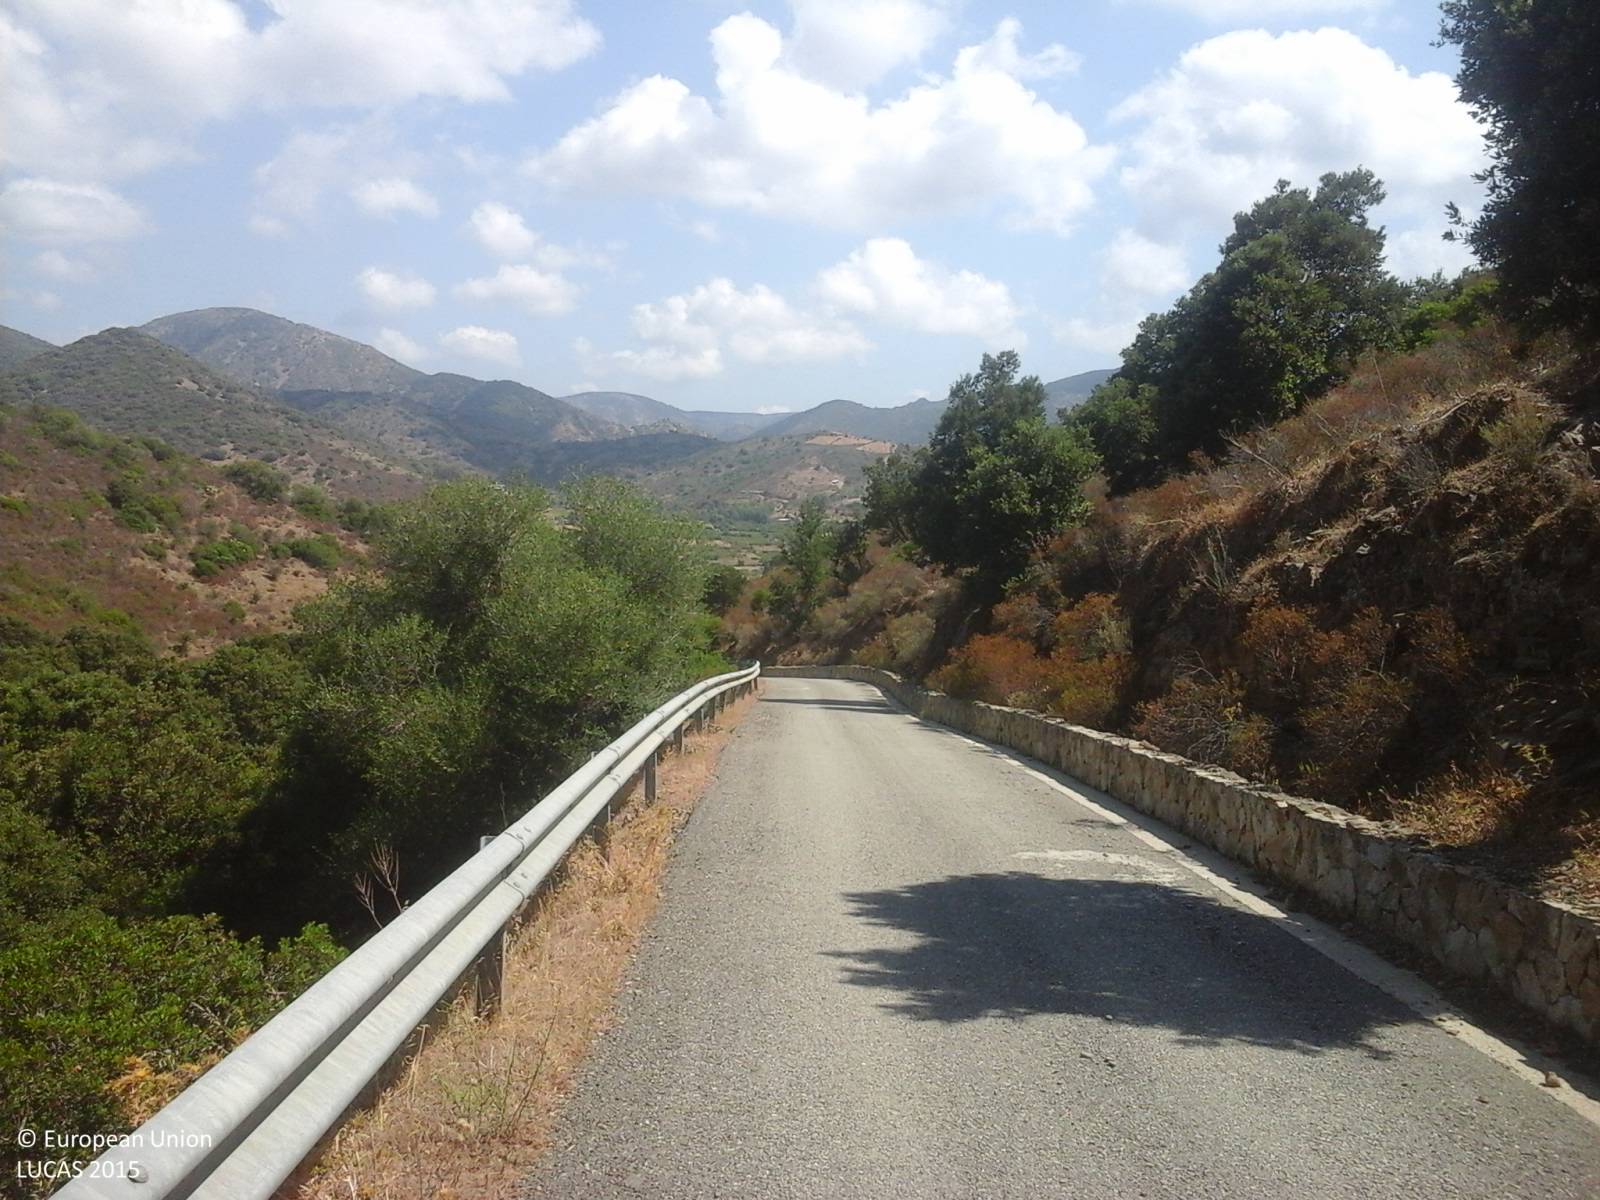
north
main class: Shrubland
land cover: Shrubland with sparse tree cover
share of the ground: > 75 %
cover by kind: shrubs 75 %, herbaceous plants 15 %, broadleaved forest trees 5 %, unconsolidated bare surface 5 %
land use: Agriculture (excluding fallow land and kitchen gardens)
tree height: < 5 m
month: July
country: IT
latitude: 39.4331
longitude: 9.5265
